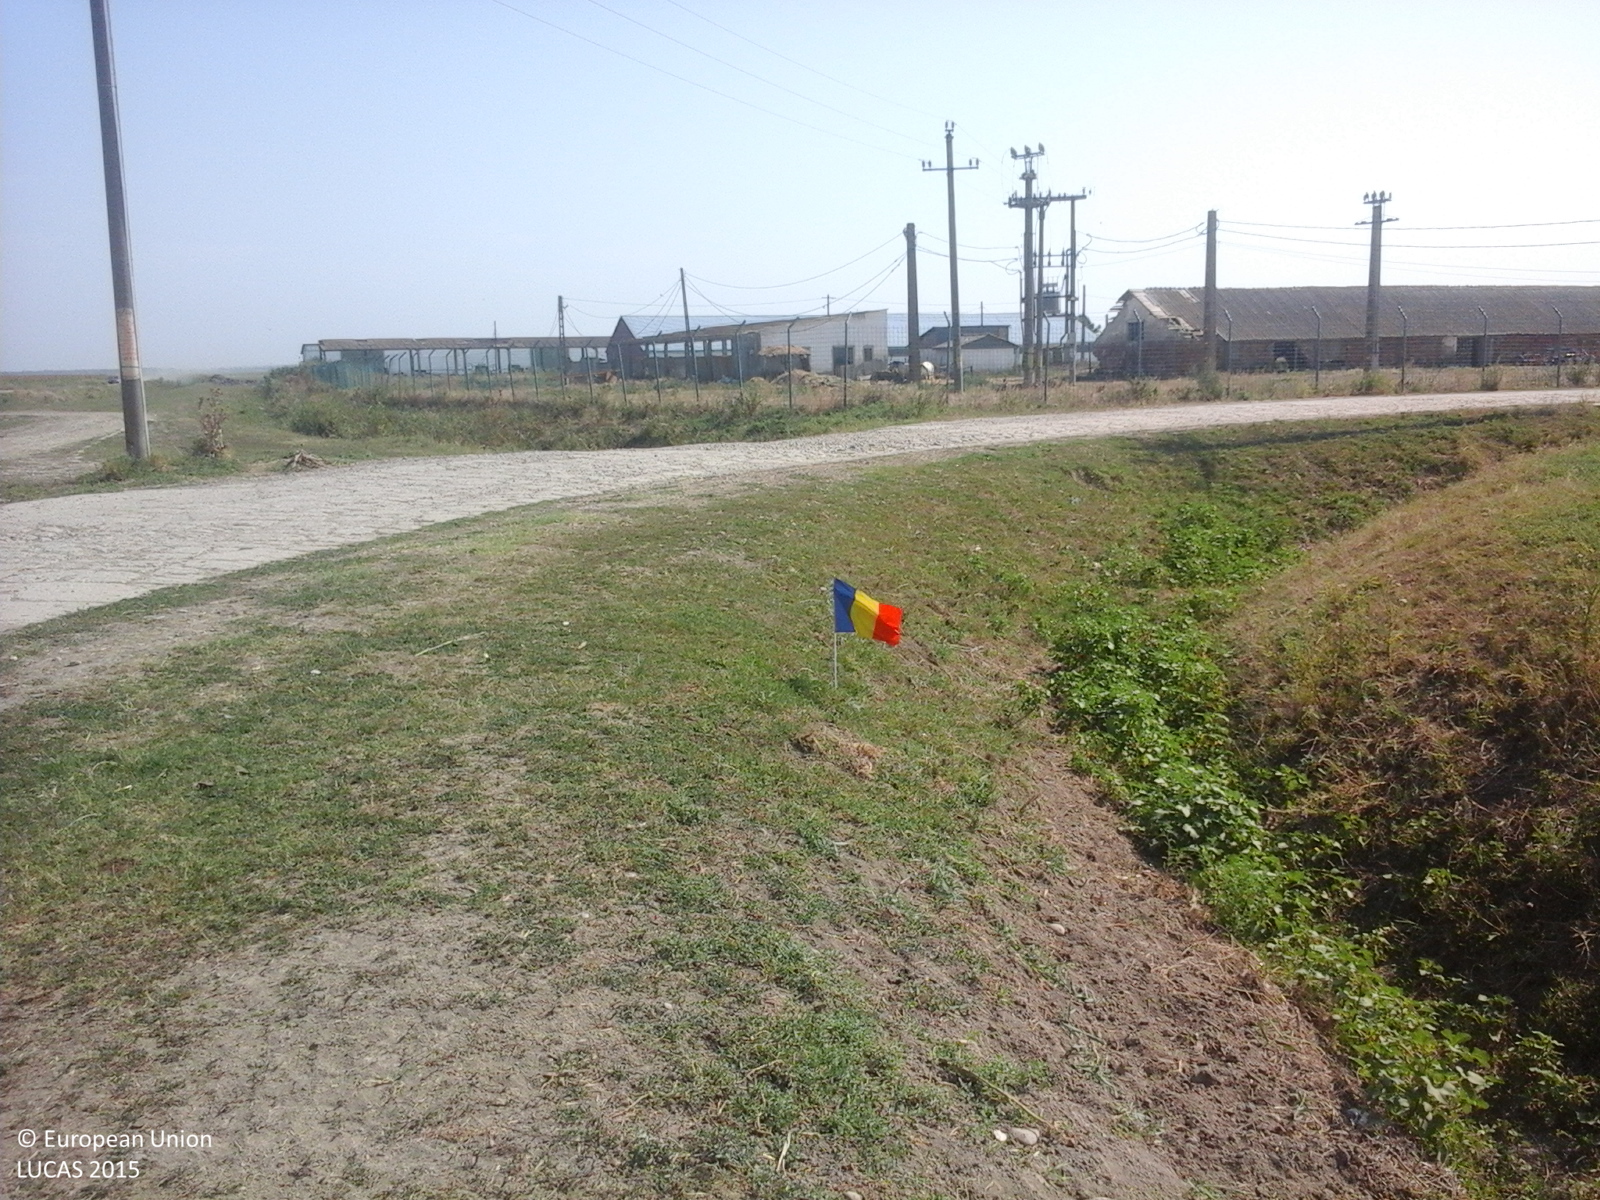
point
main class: Grassland
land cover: Grassland without tree/shrub cover
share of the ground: > 75 %
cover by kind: herbaceous plants 100 %
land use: Agriculture (excluding fallow land and kitchen gardens)
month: August
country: RO
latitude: 45.3644
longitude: 27.7659
